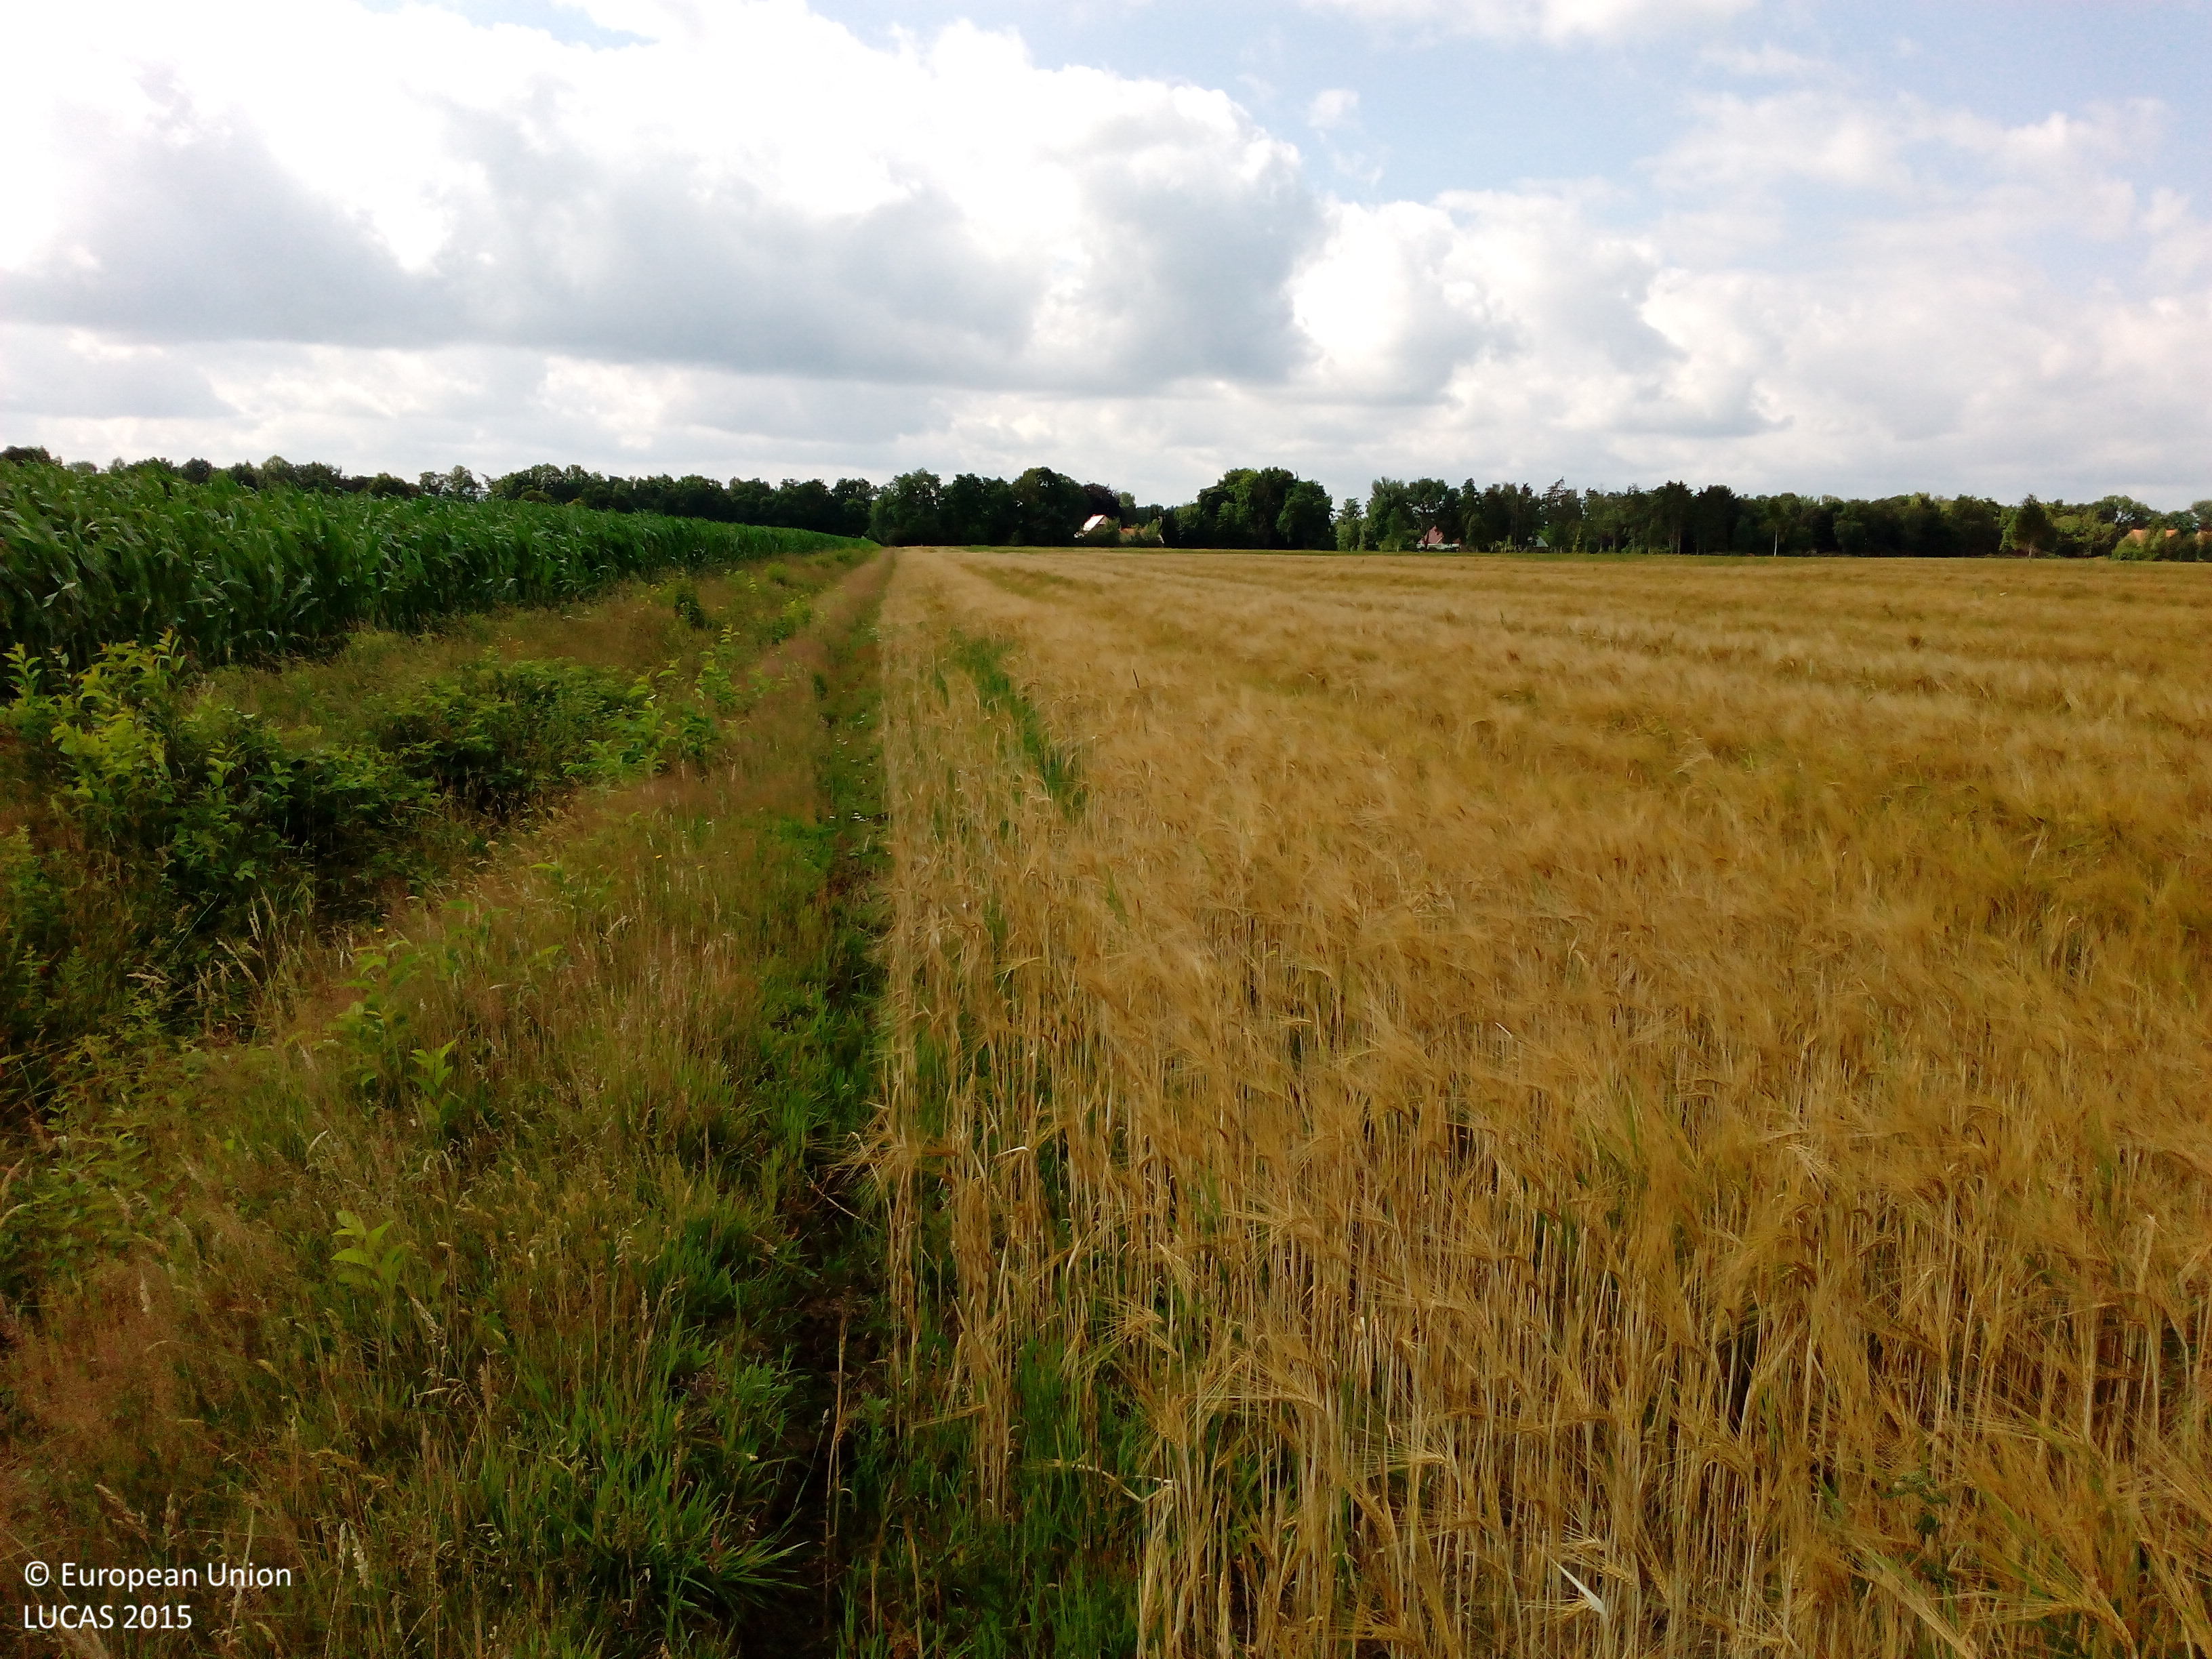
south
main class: Cropland
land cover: Barley
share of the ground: > 75 %
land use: Agriculture (excluding fallow land and kitchen gardens)
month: July
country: DE
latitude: 53.0960
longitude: 7.8950
